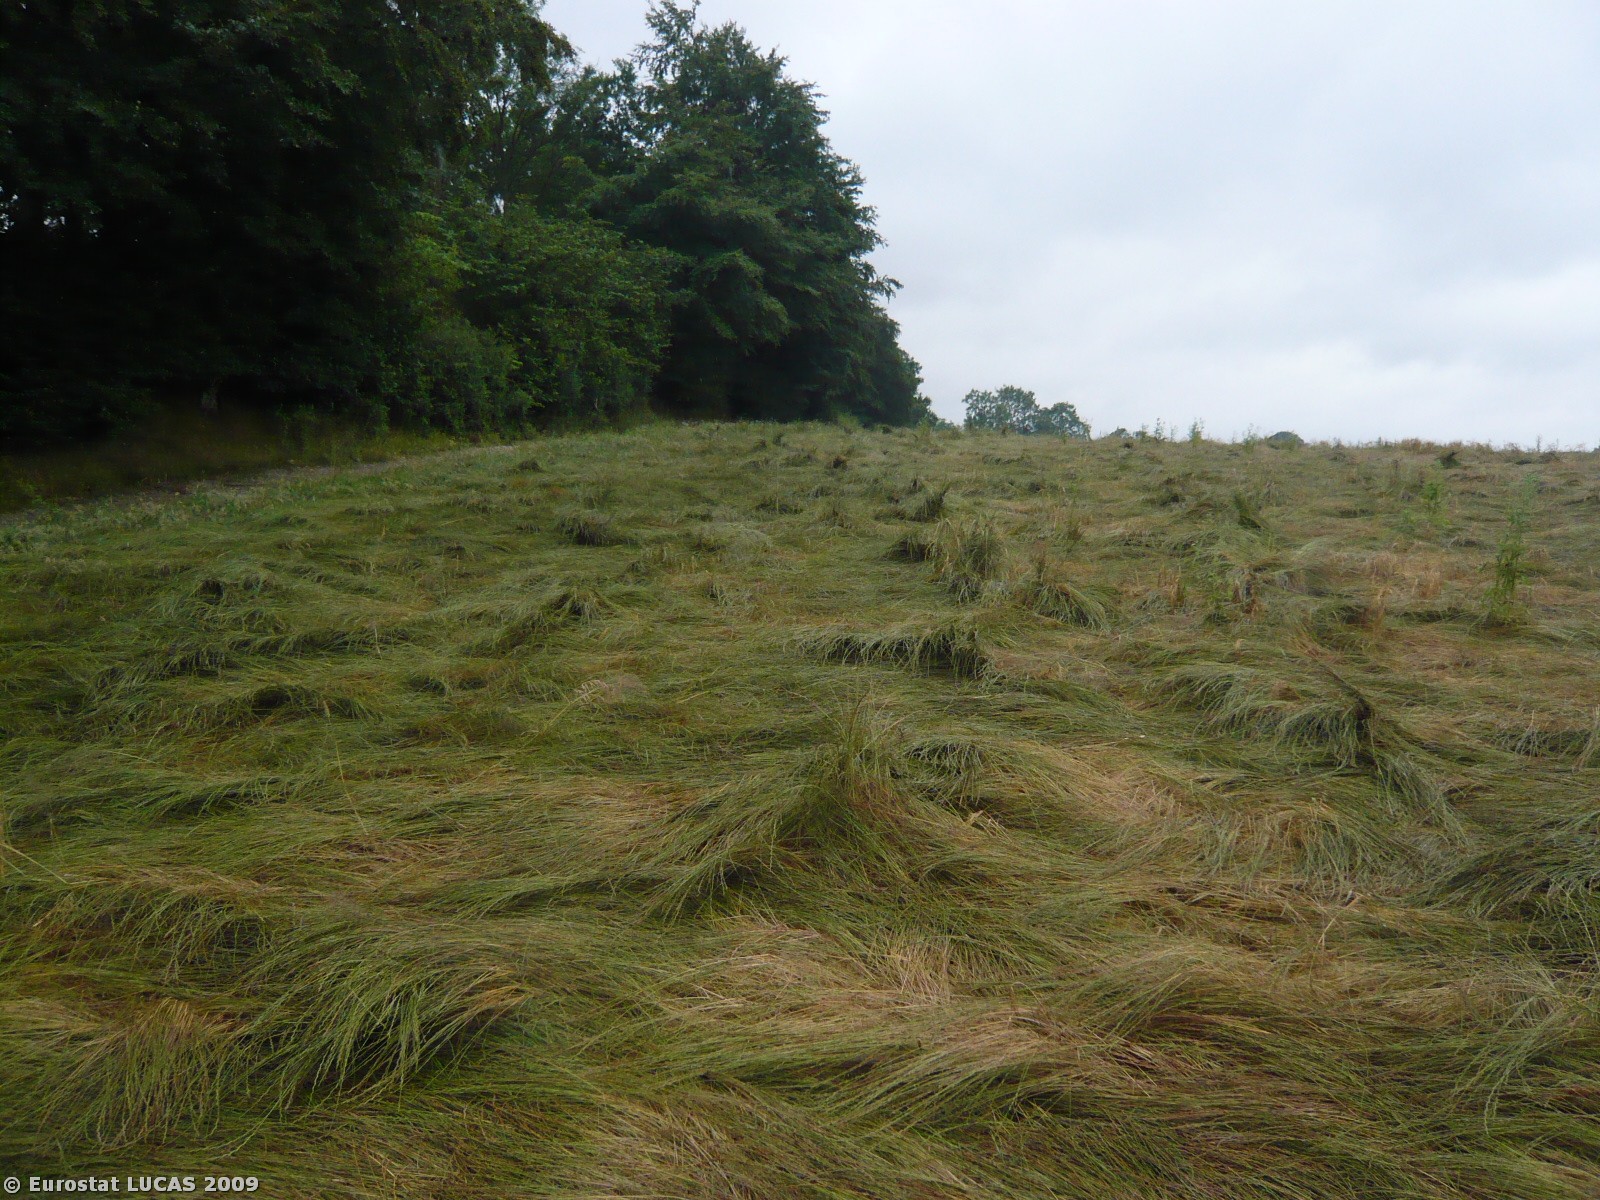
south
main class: Cropland
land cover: Temporary grasslands
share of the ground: > 75 %
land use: Agriculture (excluding fallow land and kitchen gardens)
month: July
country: DK
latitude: 55.6709
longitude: 11.8586
